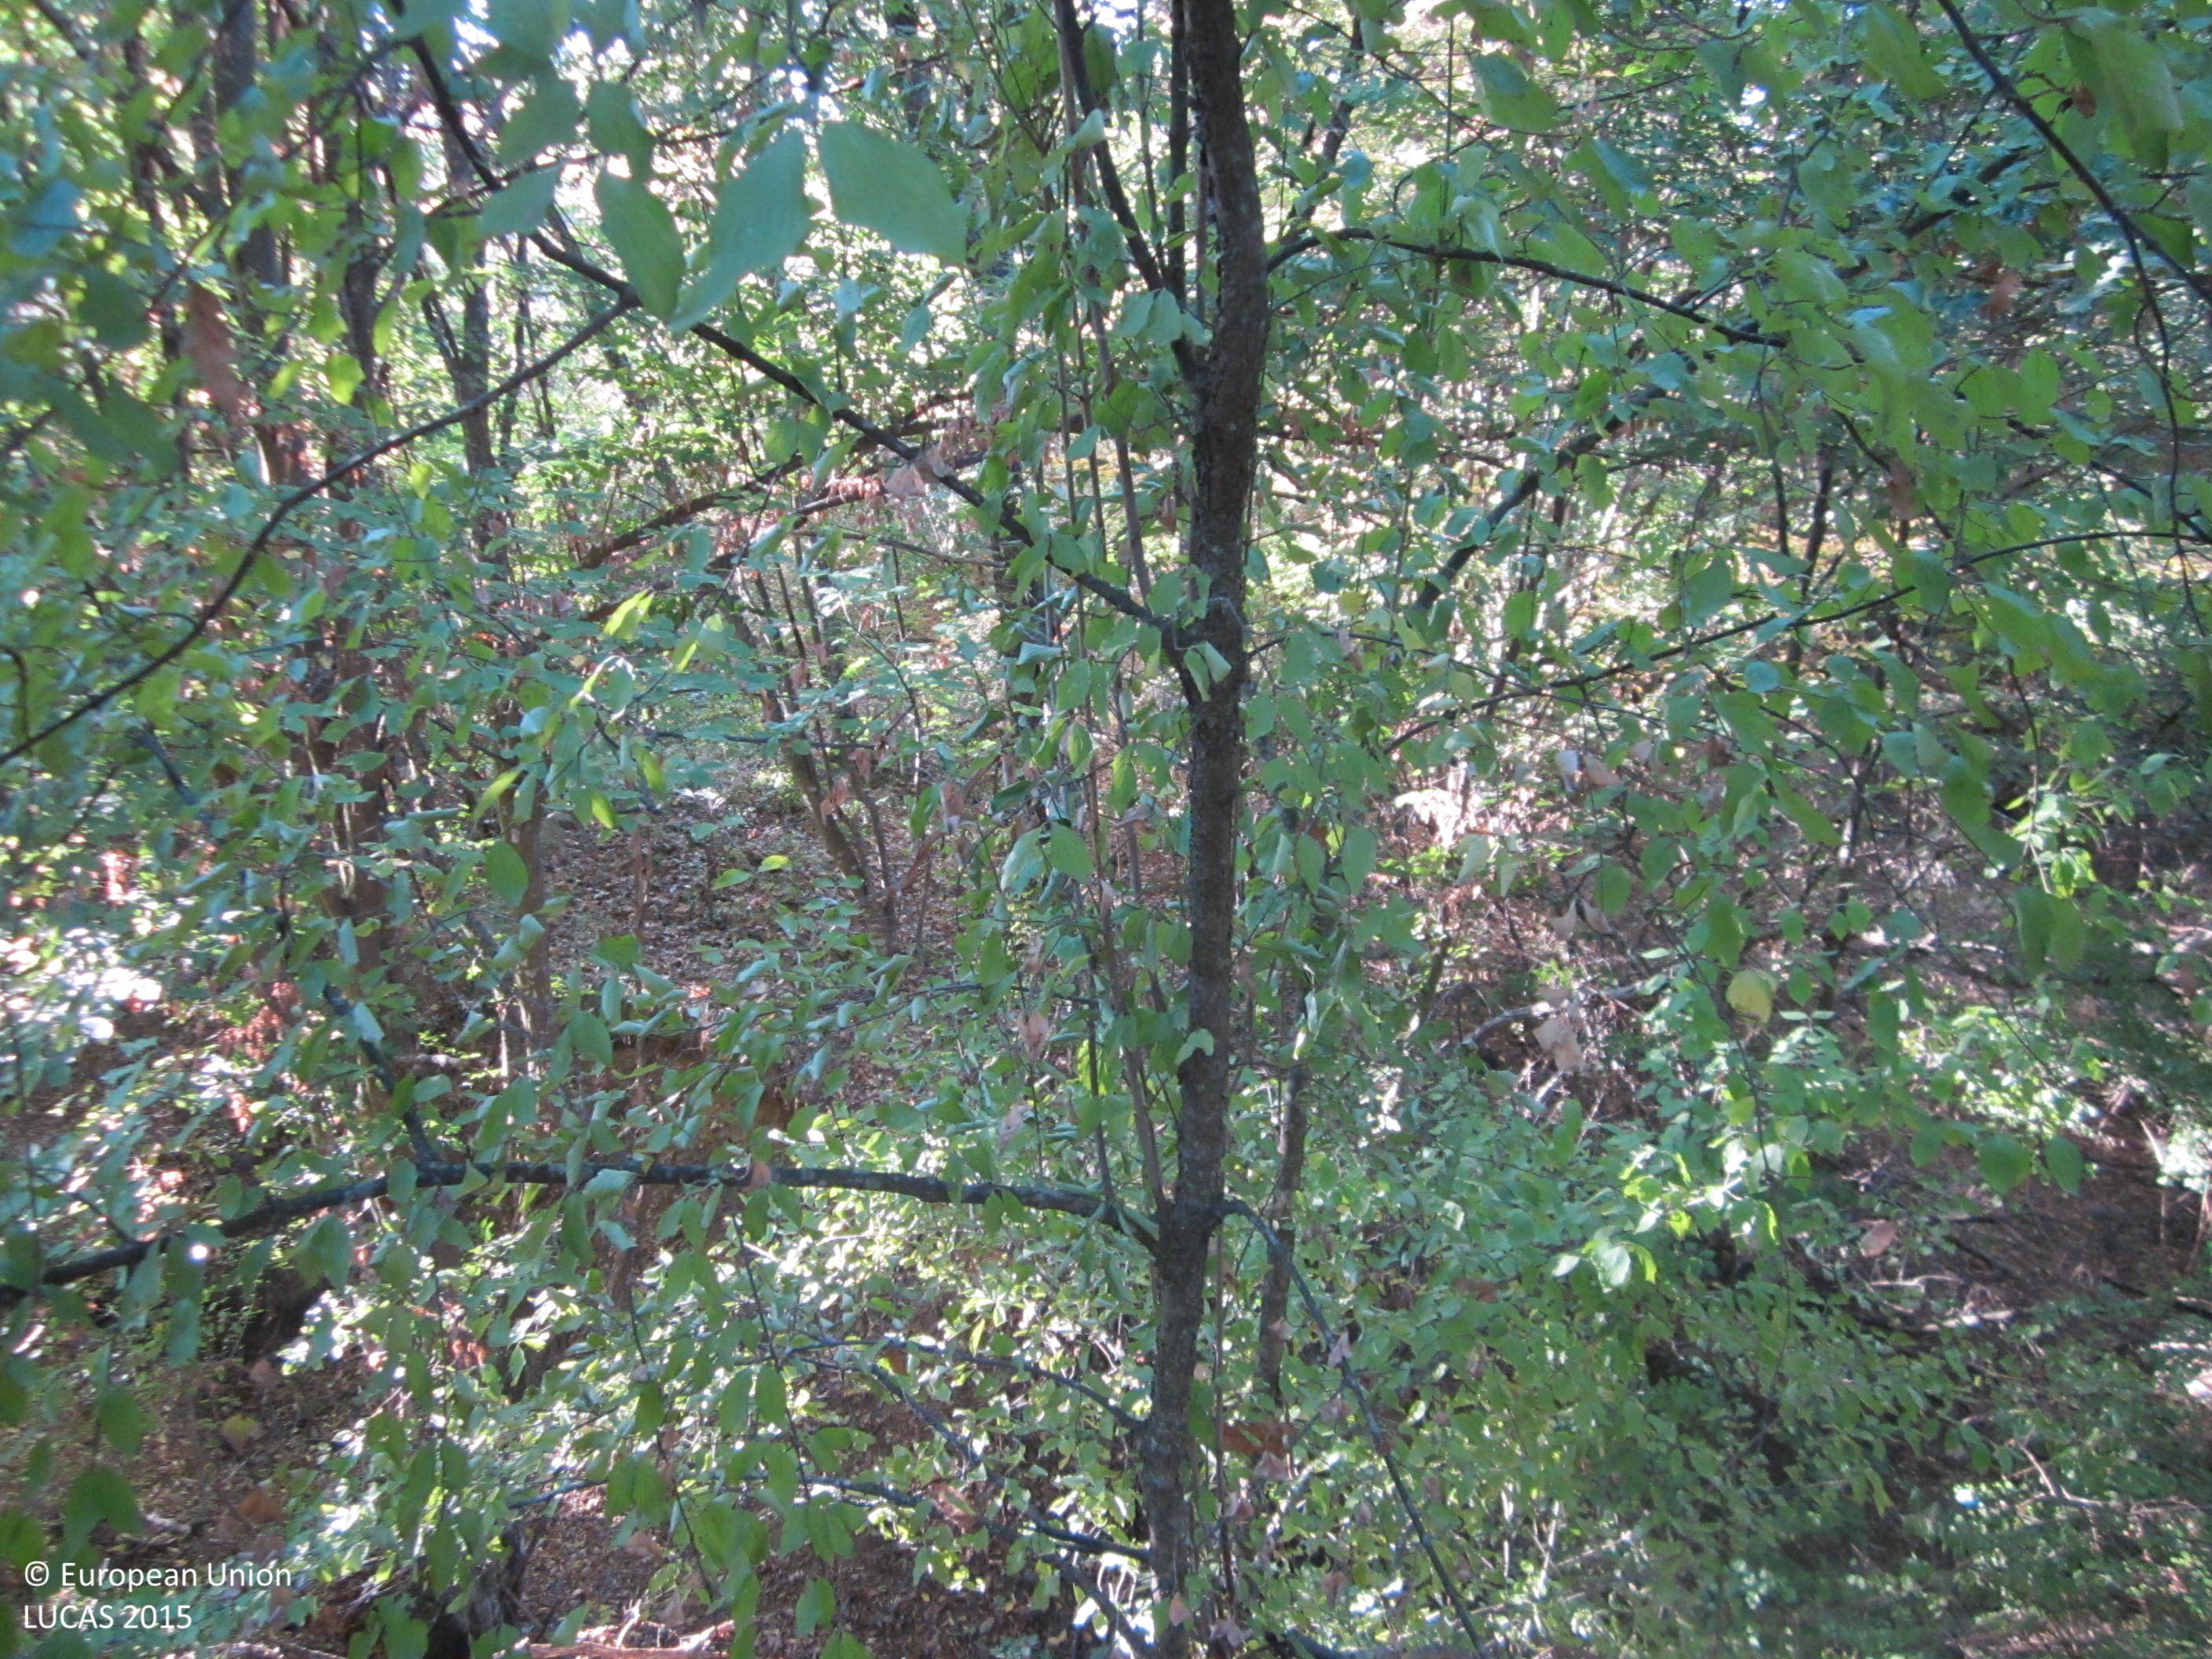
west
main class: Woodland
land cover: Broadleaved woodland
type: thermophilous deciduous forest
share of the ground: 50 - 75 %
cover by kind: broadleaved forest trees 70 %, unconsolidated bare surface 20 %, shrubs 5 %, herbaceous plants 5 %
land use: Forestry
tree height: > 5 m
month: September
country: BG
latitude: 42.1052
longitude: 27.1167
